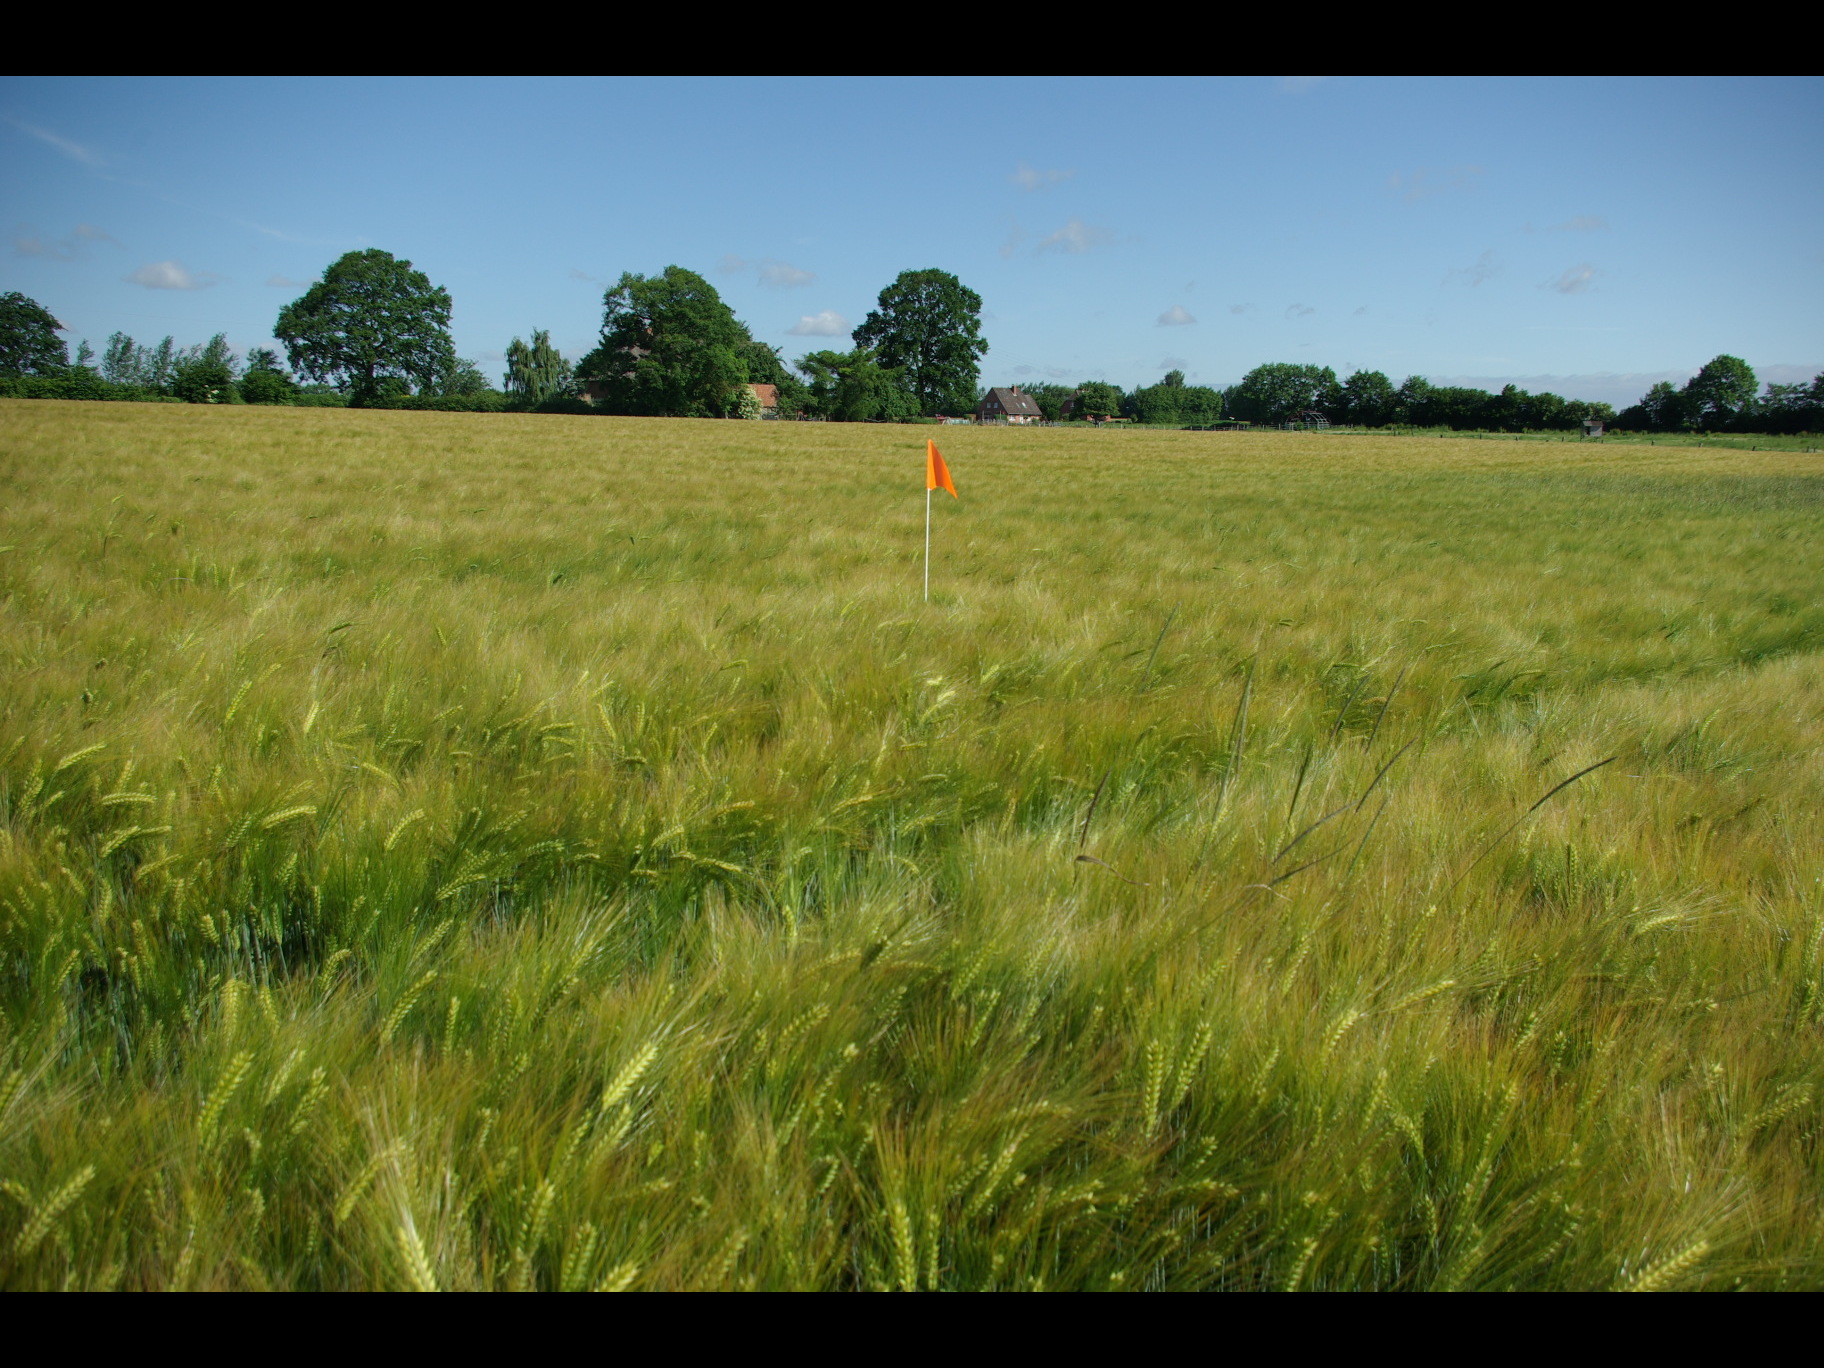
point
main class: Cropland
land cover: Barley
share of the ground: > 75 %
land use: Agriculture (excluding fallow land and kitchen gardens)
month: June
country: DE
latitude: 54.3544
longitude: 9.9231
